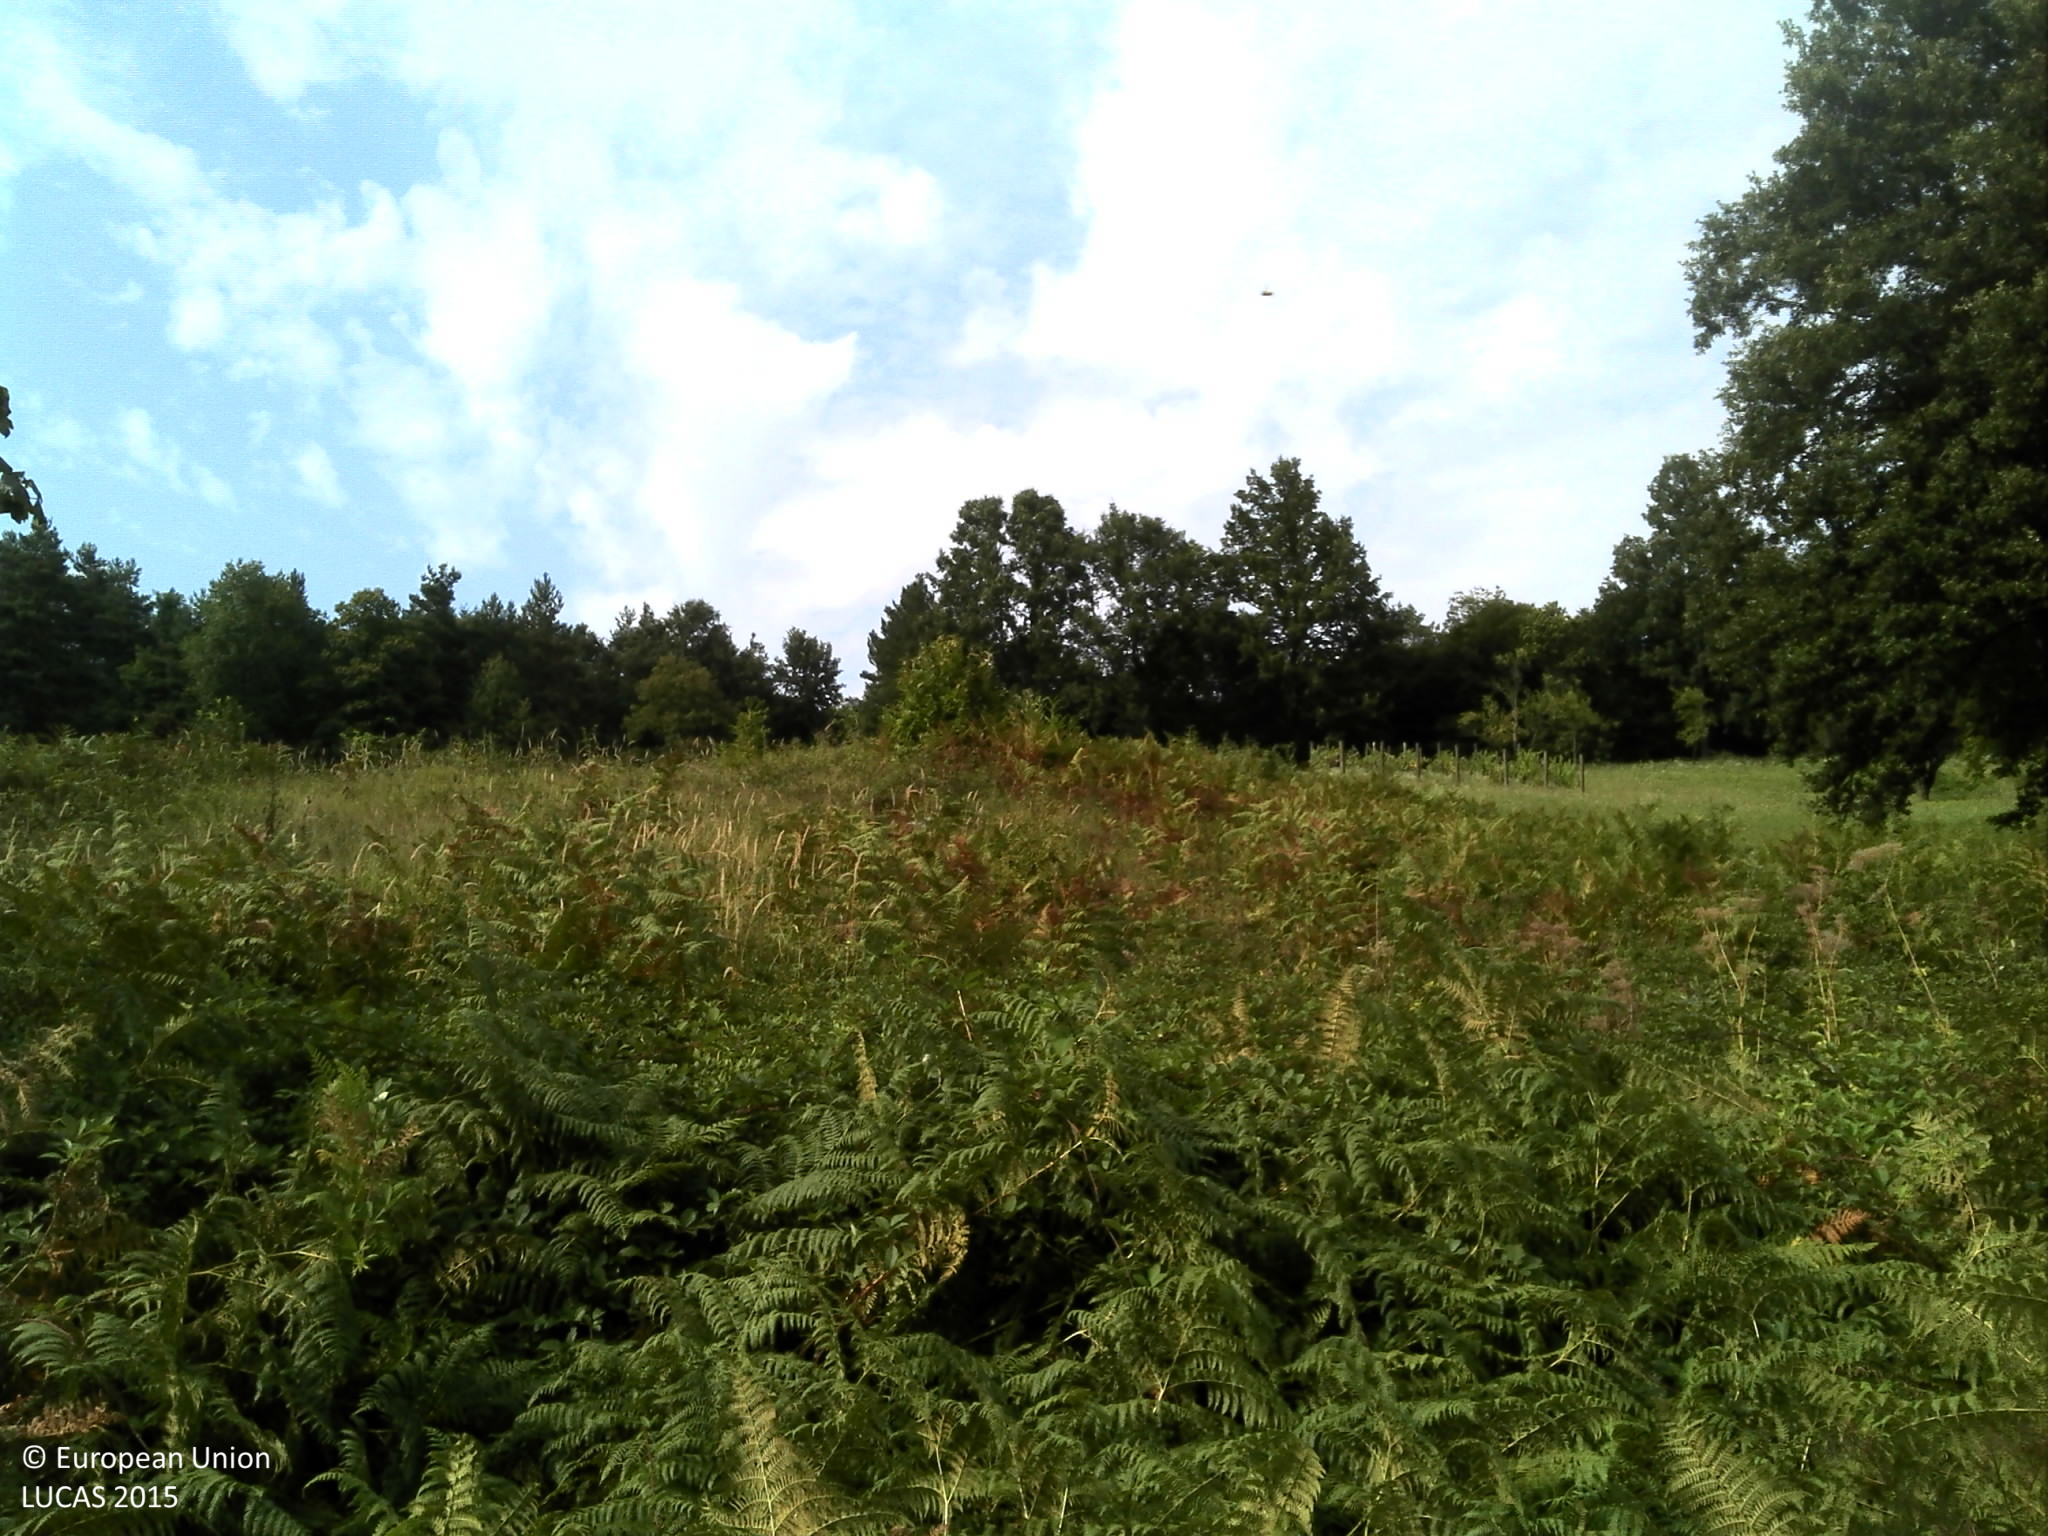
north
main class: Shrubland
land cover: Shrubland without tree cover
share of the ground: > 75 %
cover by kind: shrubs 100 %
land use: Semi-natural and natural areas not in use
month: September
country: HR
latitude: 45.1361
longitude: 15.6540
